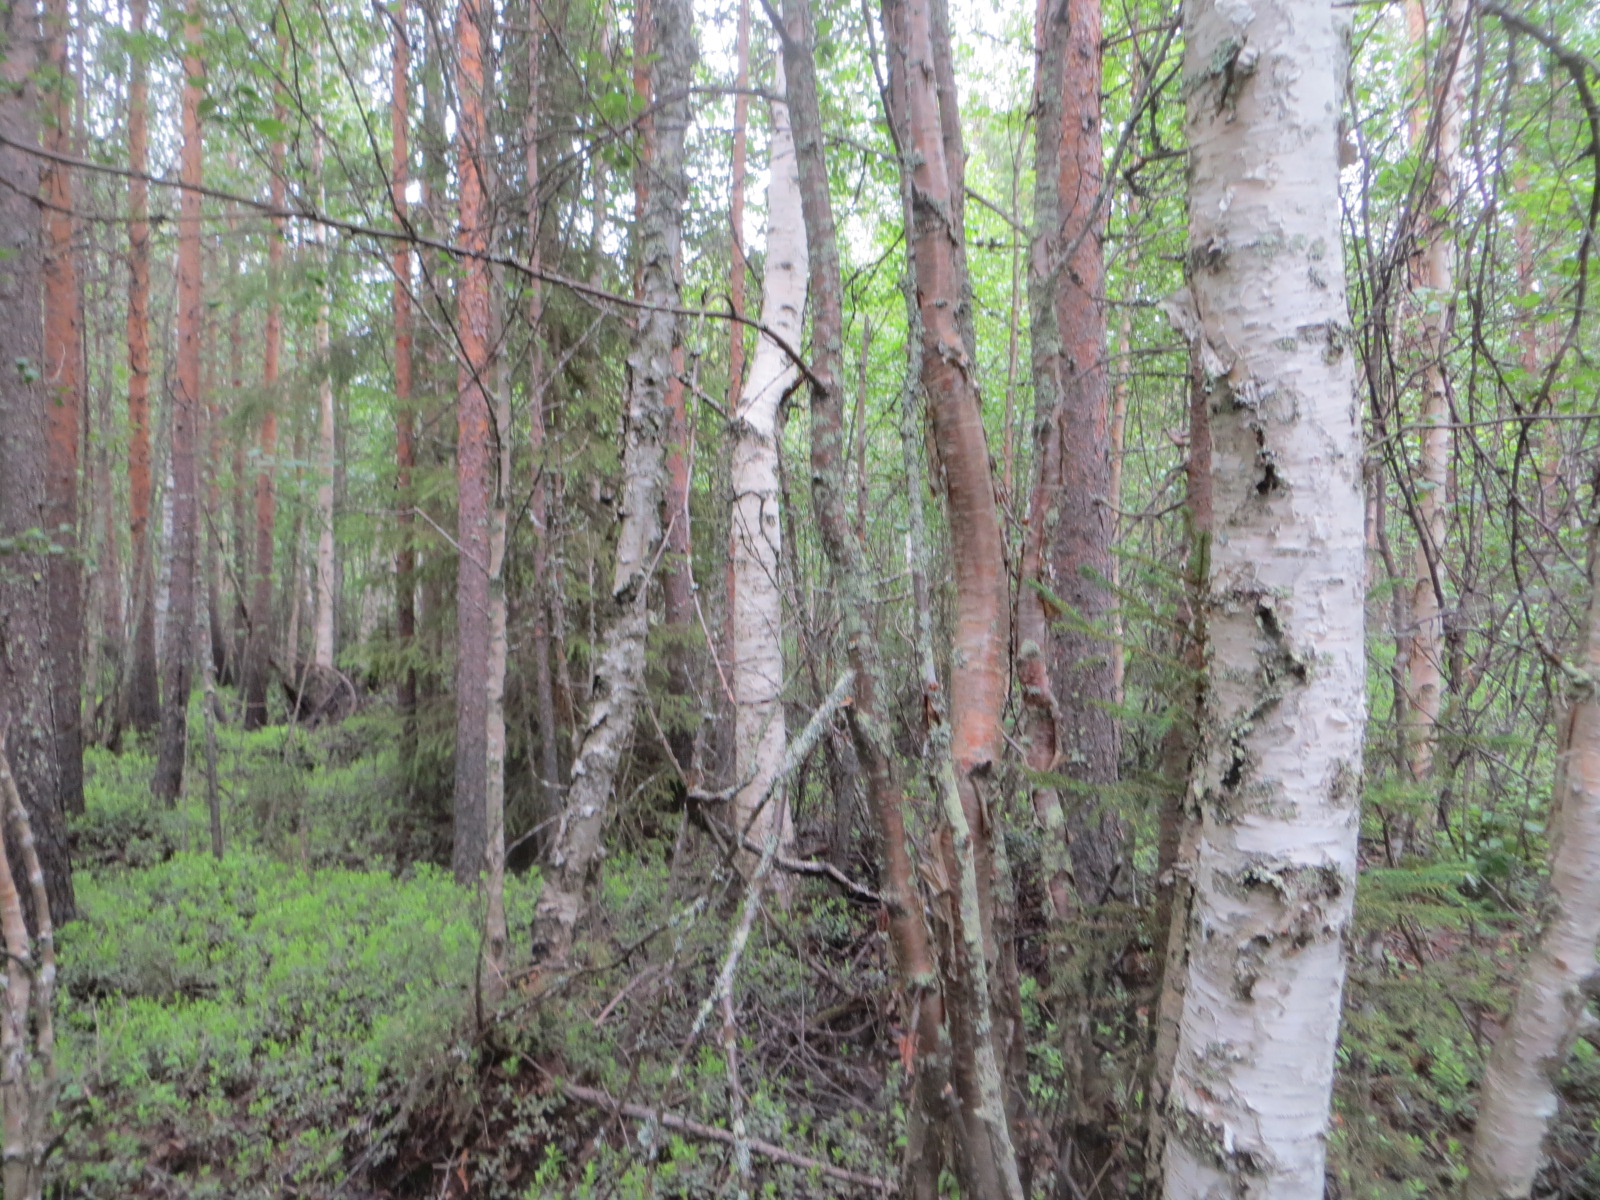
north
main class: Woodland
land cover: Pine dominated mixed woodland
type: boreal forest
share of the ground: > 75 %
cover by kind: broadleaved forest trees 40 %, coniferous forest trees 35 %, shrubs 25 %
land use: Forestry
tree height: > 5 m
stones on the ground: < 10 %
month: July
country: FI
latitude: 66.4723
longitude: 24.3423
